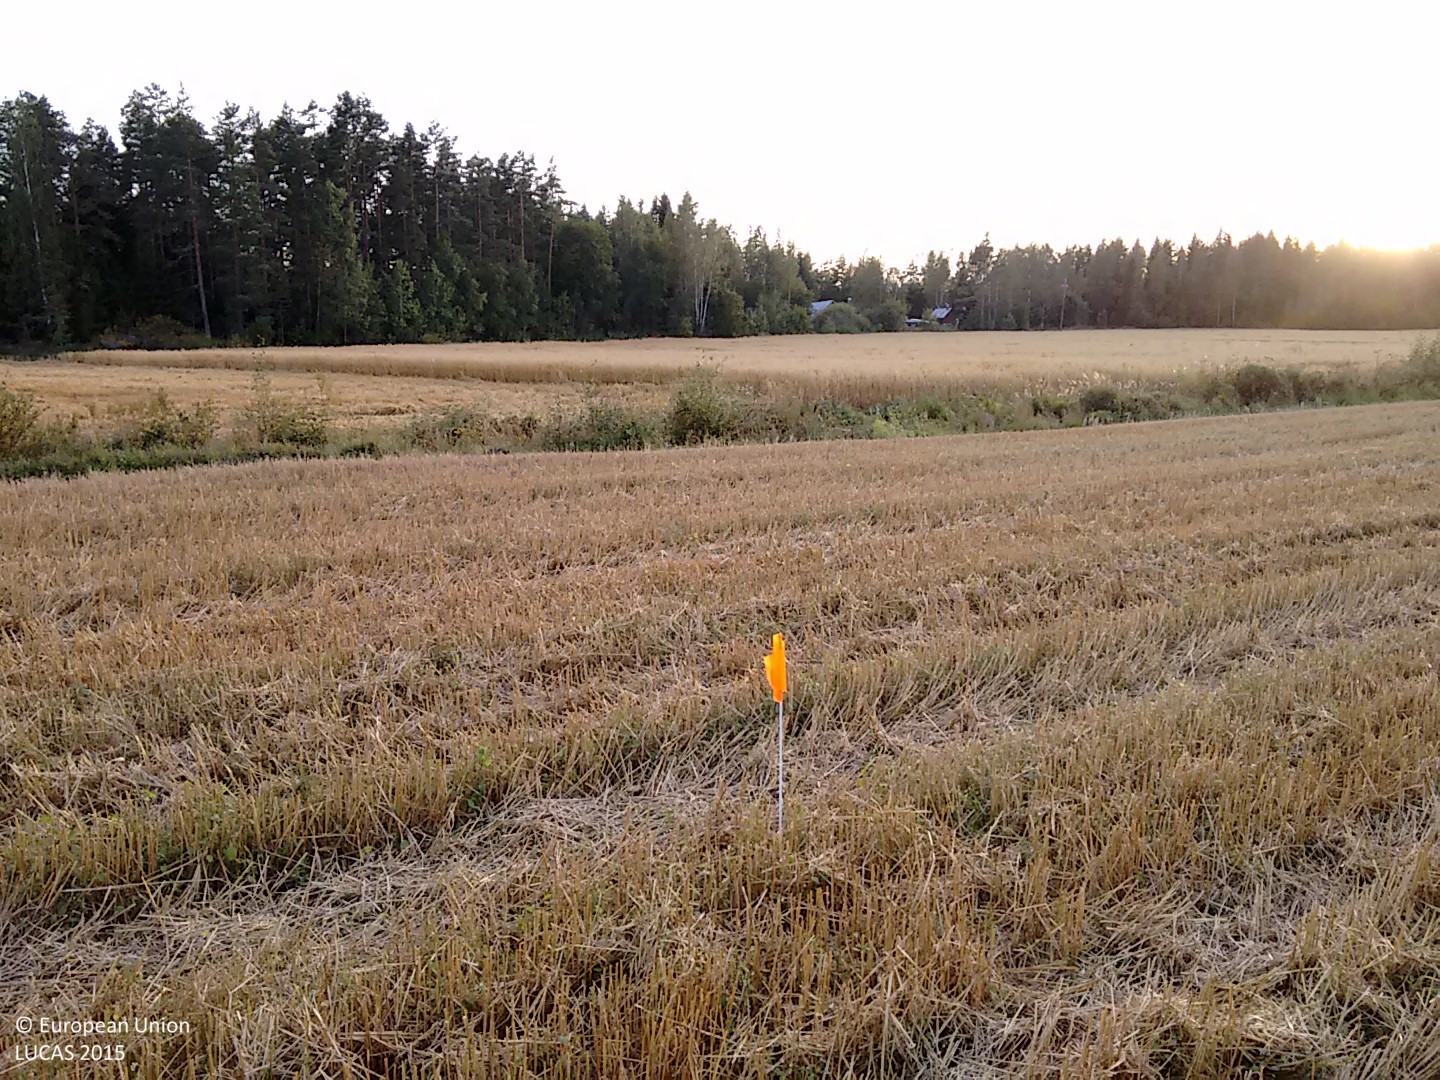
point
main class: Cropland
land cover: Barley
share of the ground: > 75 %
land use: Agriculture (excluding fallow land and kitchen gardens)
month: September
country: FI
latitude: 60.8693
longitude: 22.0125
